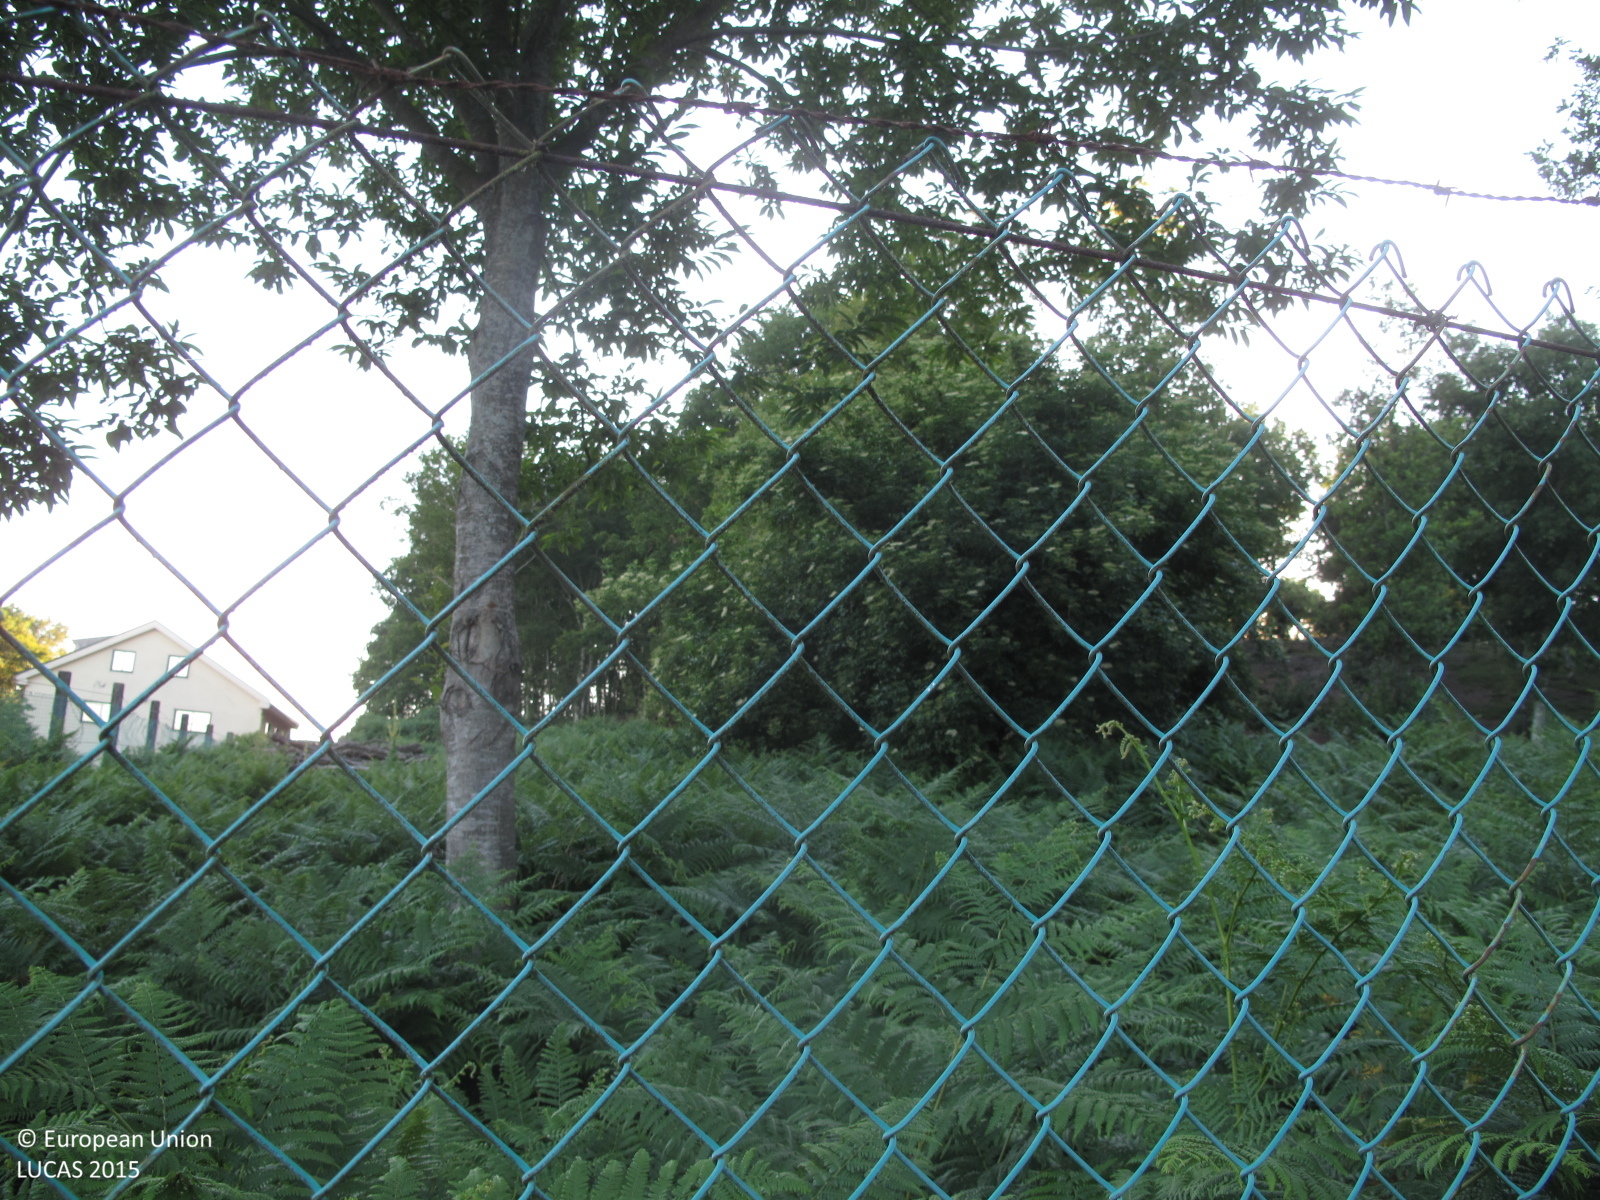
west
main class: Woodland
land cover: Broadleaved woodland
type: thermophilous deciduous forest
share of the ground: 10 - 25 %
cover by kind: herbaceous plants 70 %, broadleaved forest trees 20 %, shrubs 10 %
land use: Forestry
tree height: > 5 m
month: June
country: ES
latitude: 42.9590
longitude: -8.5301
